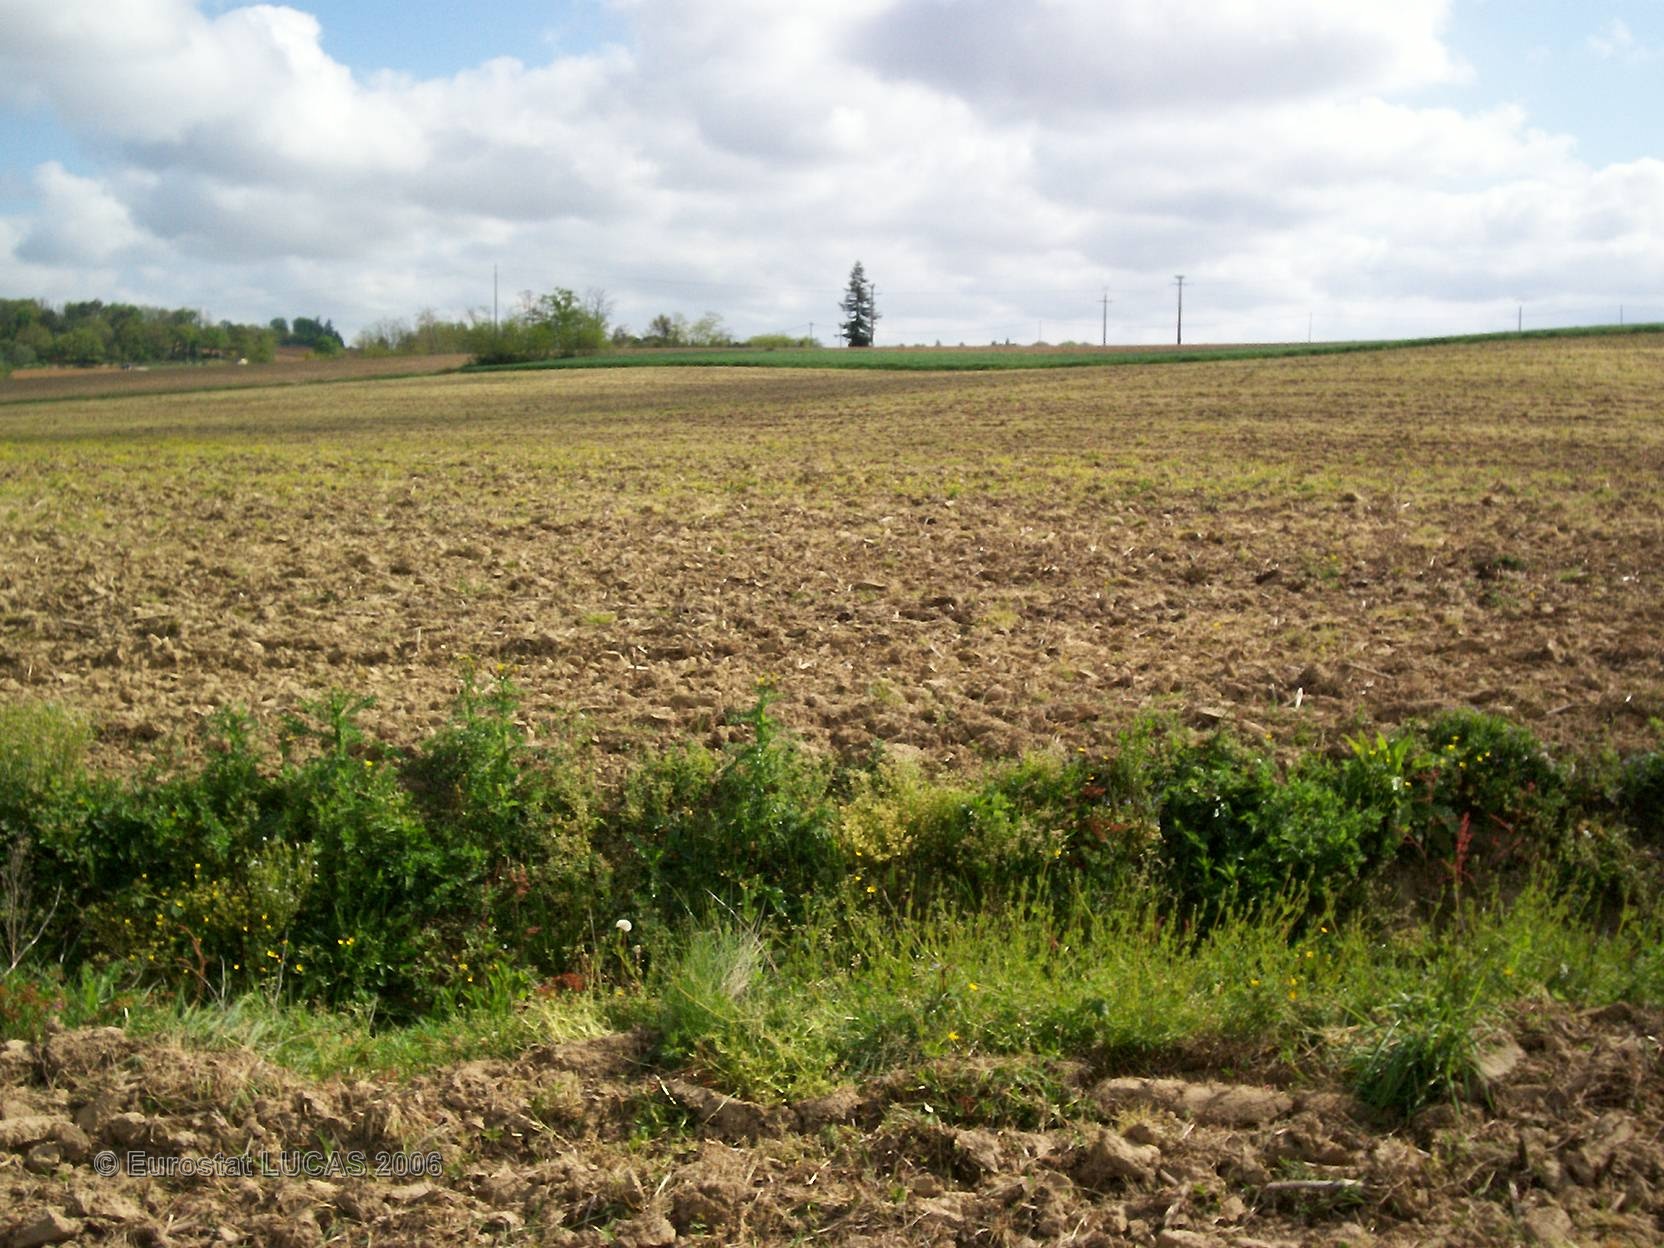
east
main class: Cropland
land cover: Maize
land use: Agriculture (excluding fallow land and kitchen gardens)
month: June
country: FR
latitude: 43.7051
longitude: -0.6970
